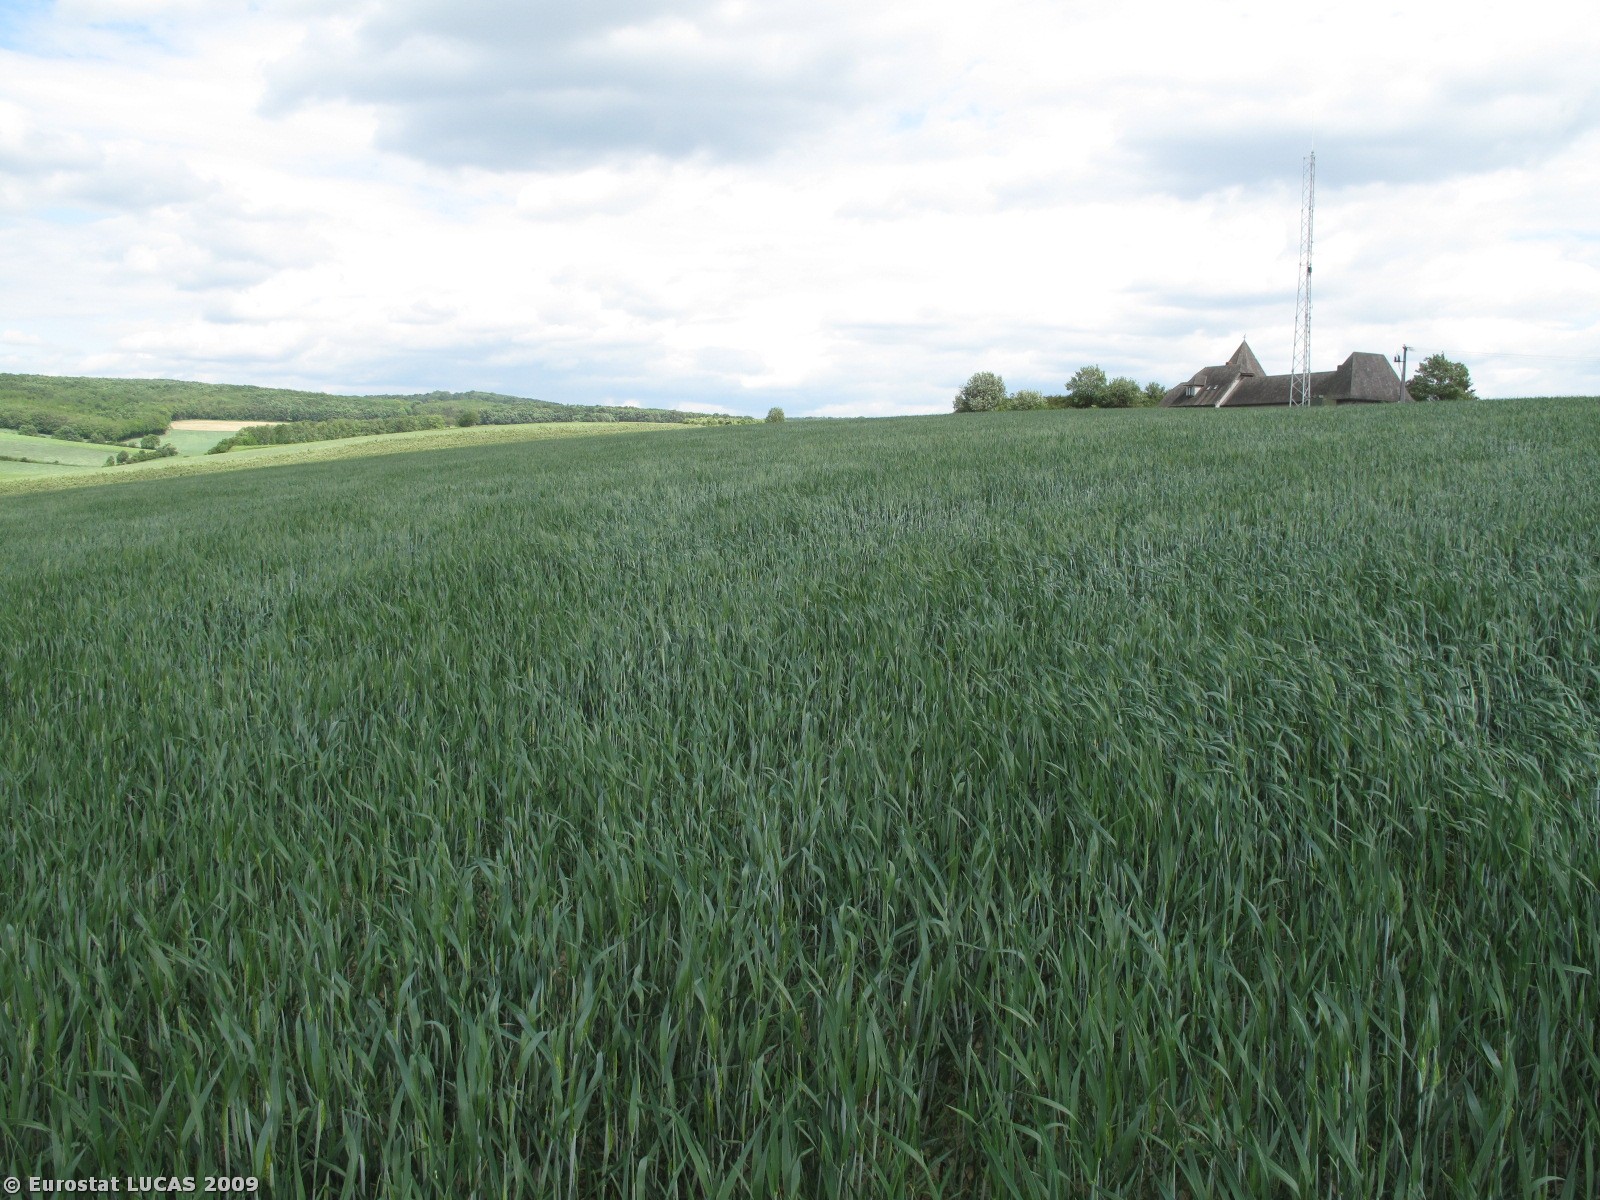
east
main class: Cropland
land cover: Common wheat
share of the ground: > 75 %
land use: Agriculture (excluding fallow land and kitchen gardens)
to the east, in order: Common wheat; Maize
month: May
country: AT
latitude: 48.4753
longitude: 15.9967
